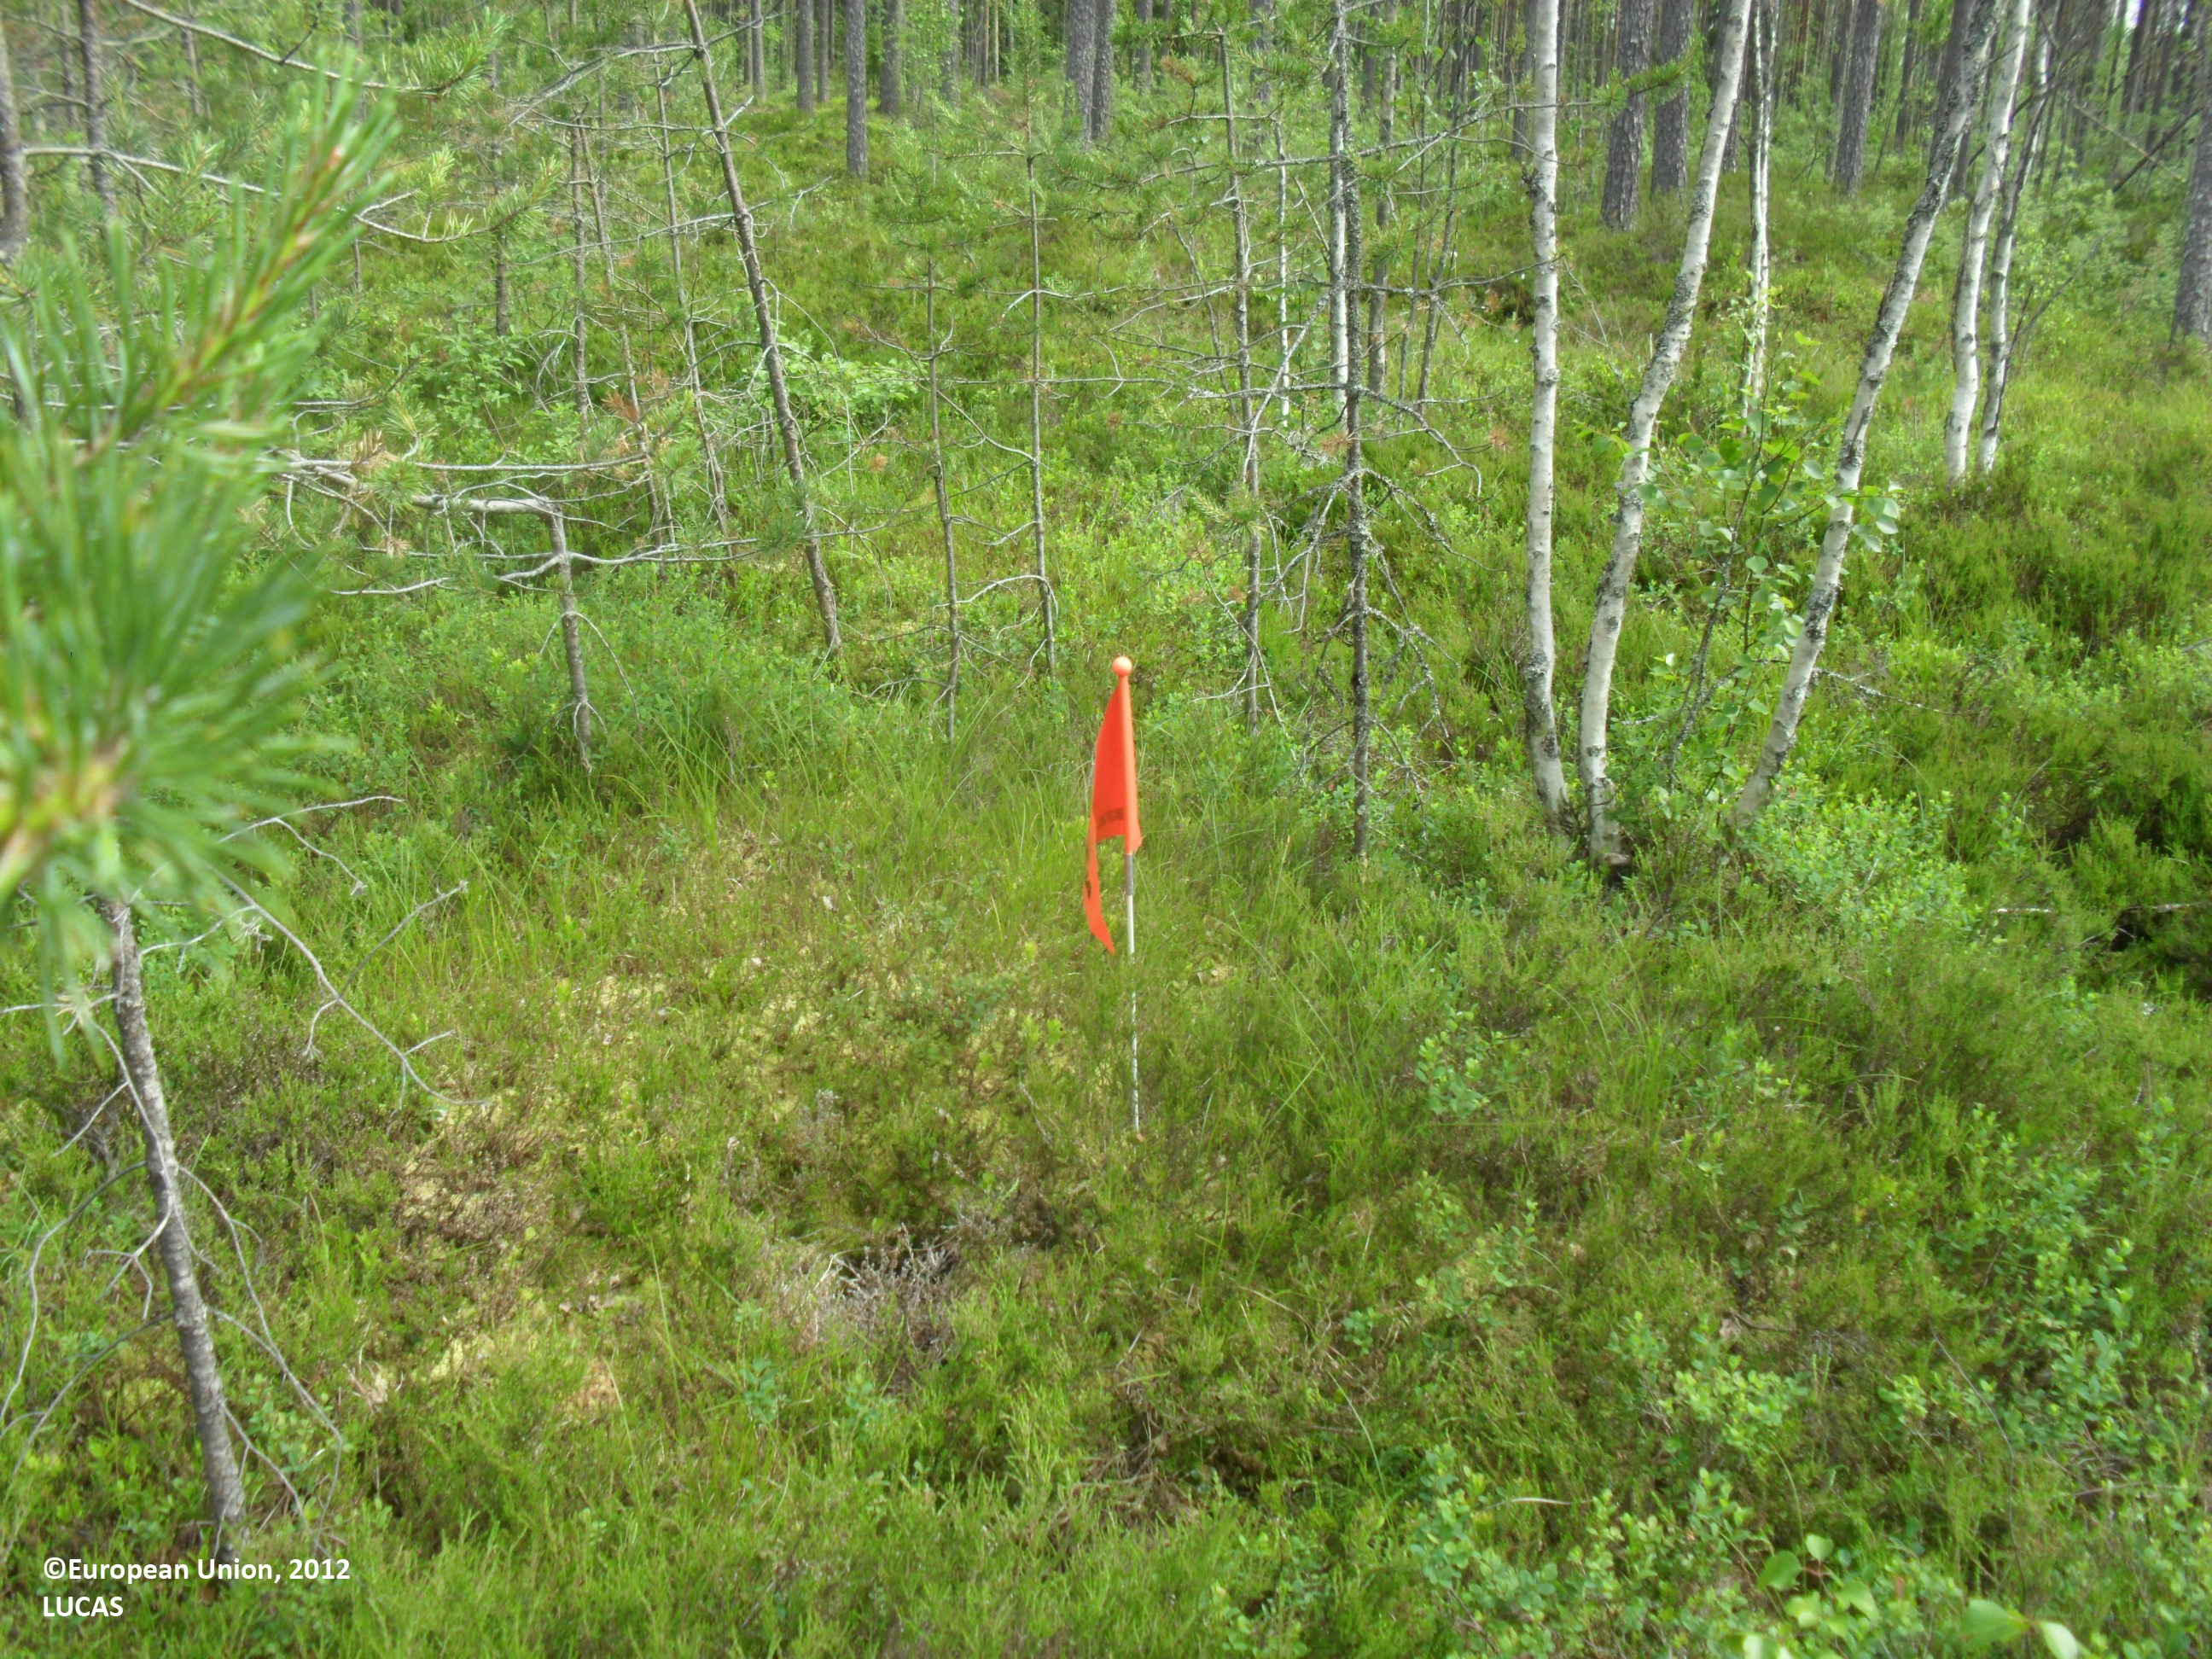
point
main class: Woodland
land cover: Other mixed woodland
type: boreal forest
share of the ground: 25 - 50 %
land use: Forestry
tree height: < 5 m
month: July
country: FI
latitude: 63.5585
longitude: 23.9377
